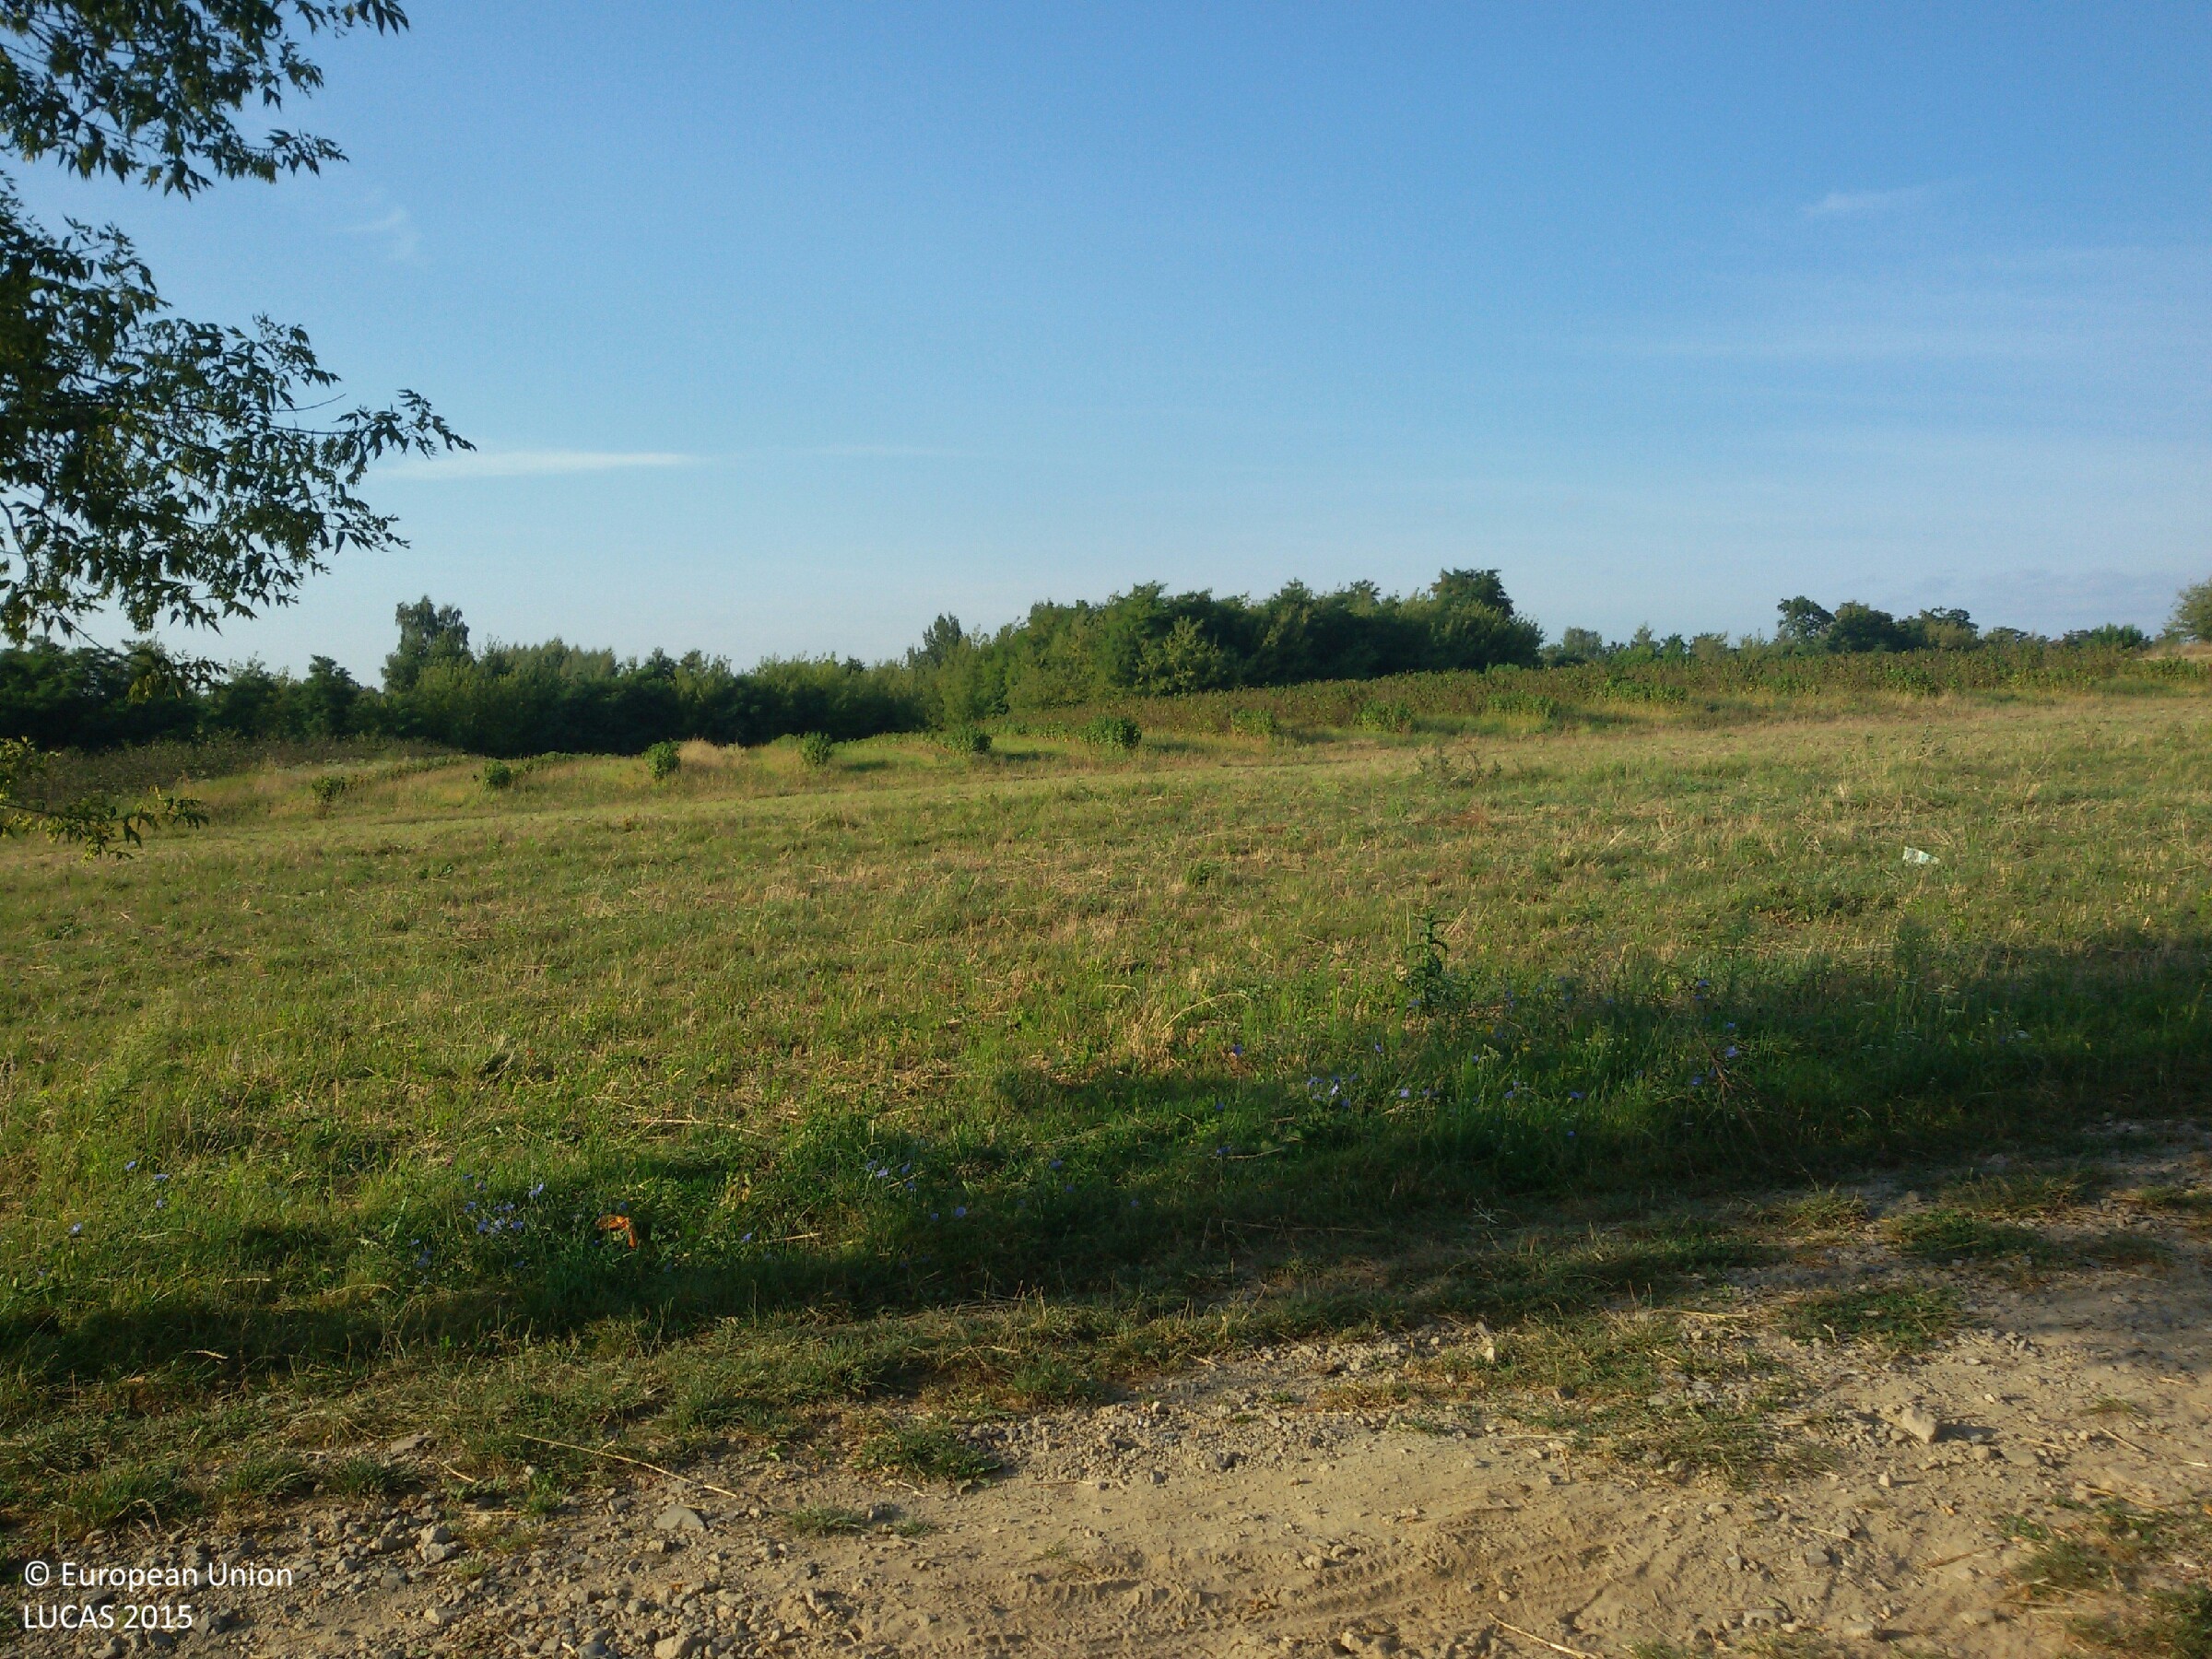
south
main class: Grassland
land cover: Grassland without tree/shrub cover
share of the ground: > 75 %
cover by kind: herbaceous plants 100 %
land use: Residential
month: August
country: PL
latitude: 50.7586
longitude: 21.7209
